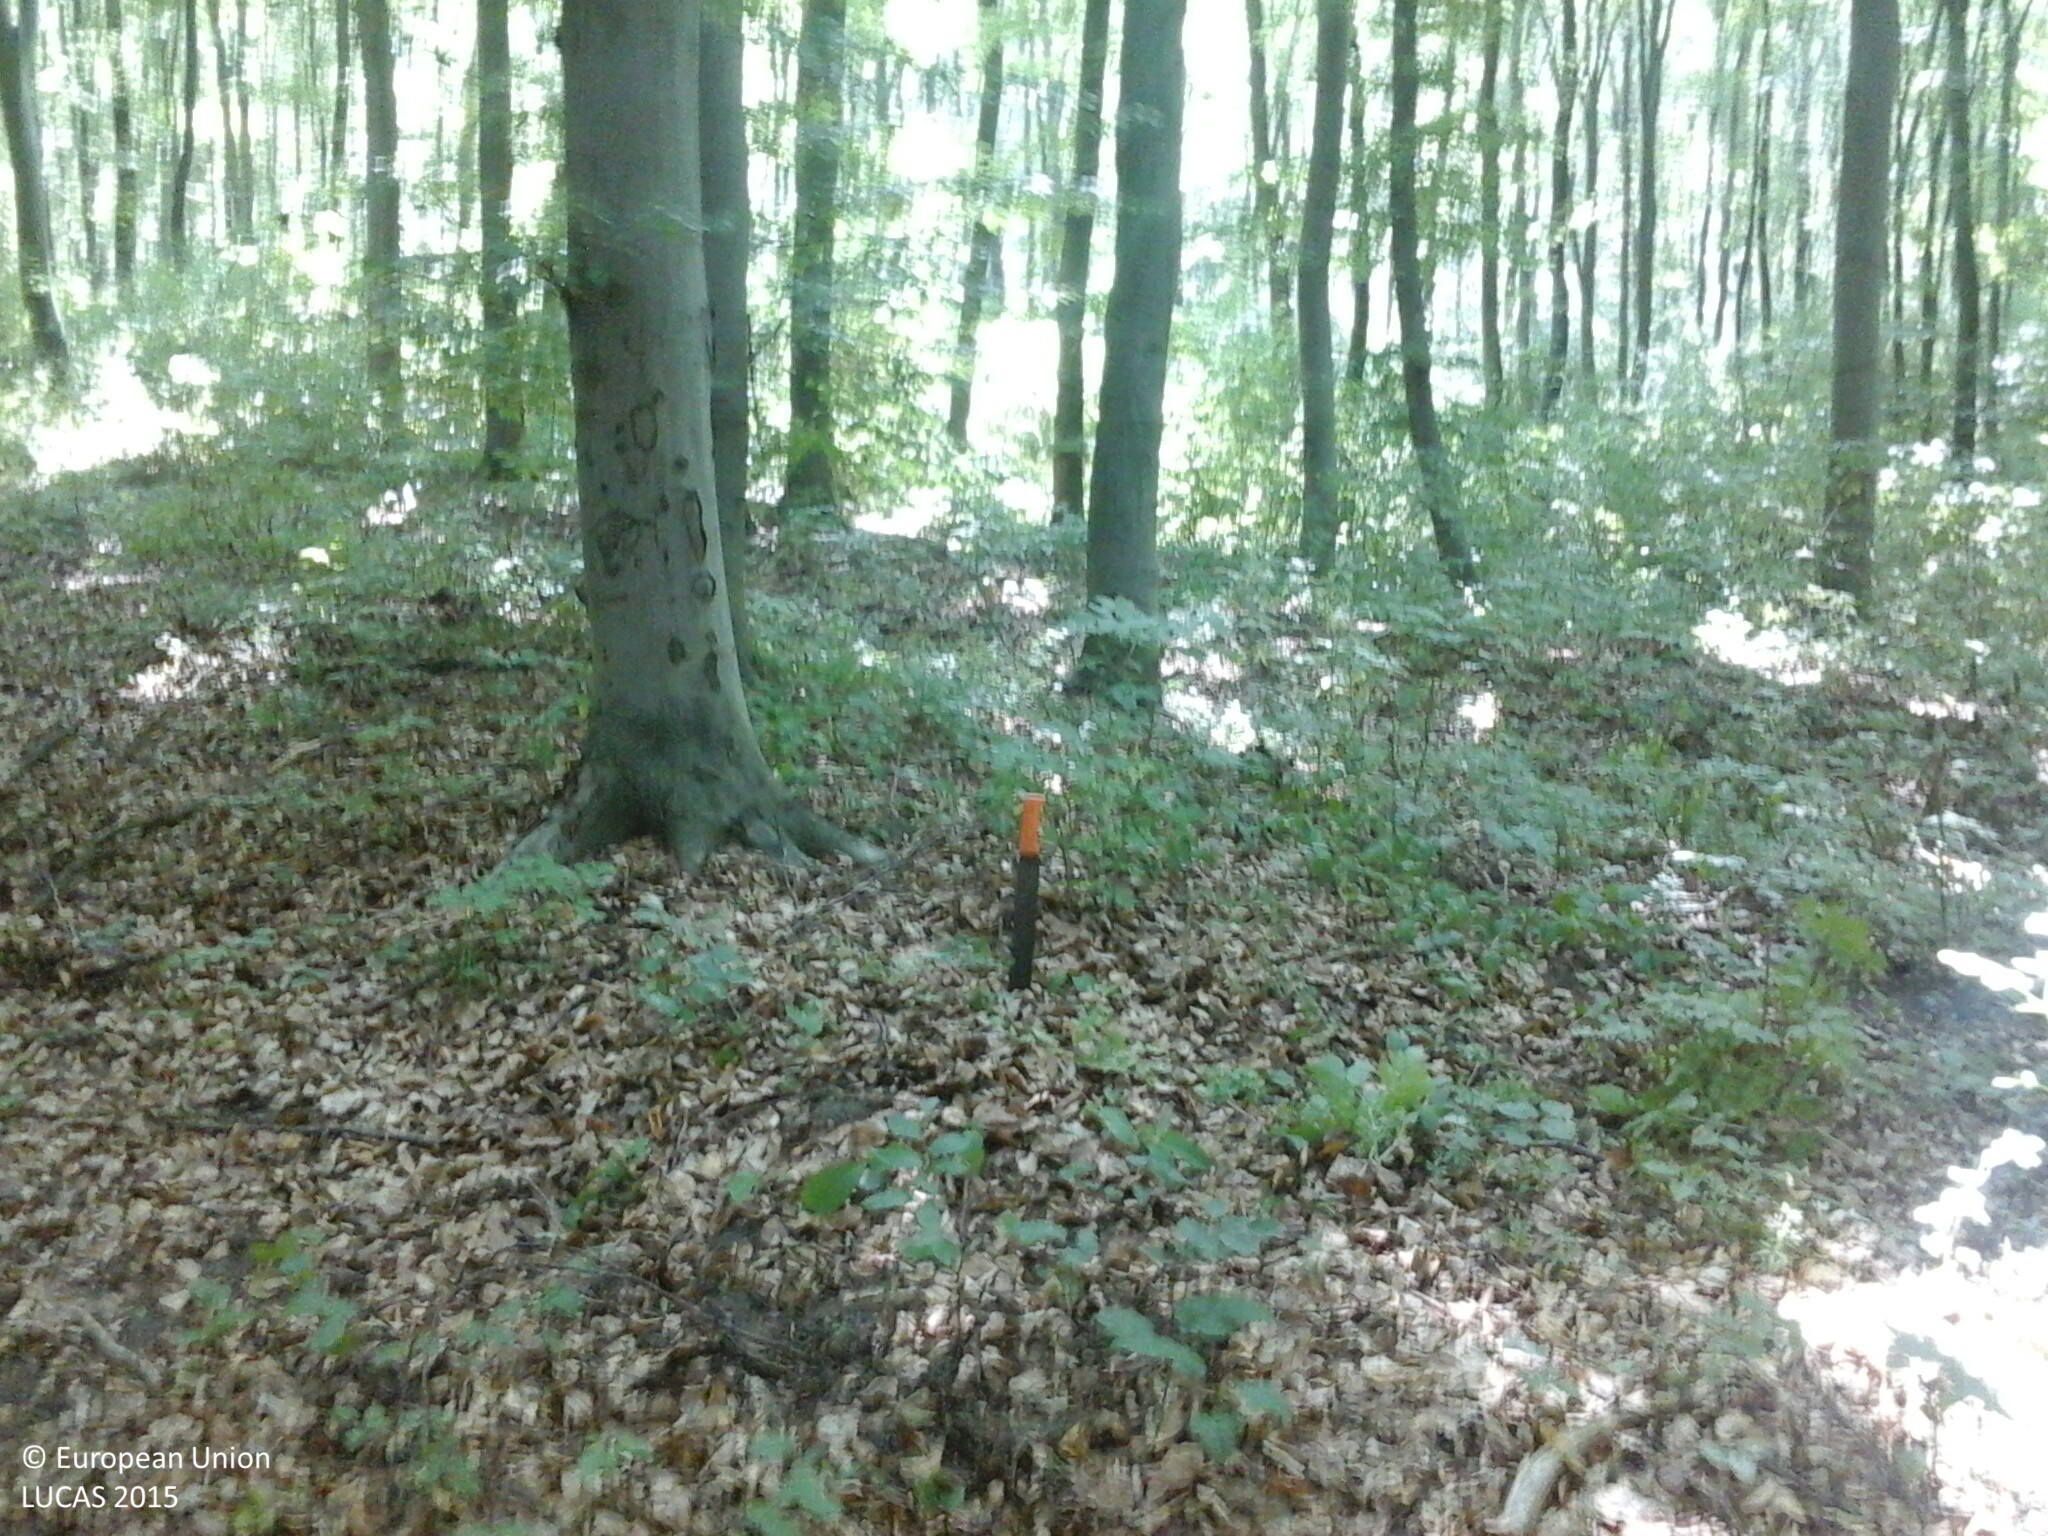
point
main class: Woodland
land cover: Broadleaved woodland
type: beech forest
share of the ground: > 75 %
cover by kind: broadleaved forest trees 100 %
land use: Forestry
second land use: Amenities, museums, leisure
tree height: > 5 m
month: August
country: HU
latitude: 47.3107
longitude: 18.0929
